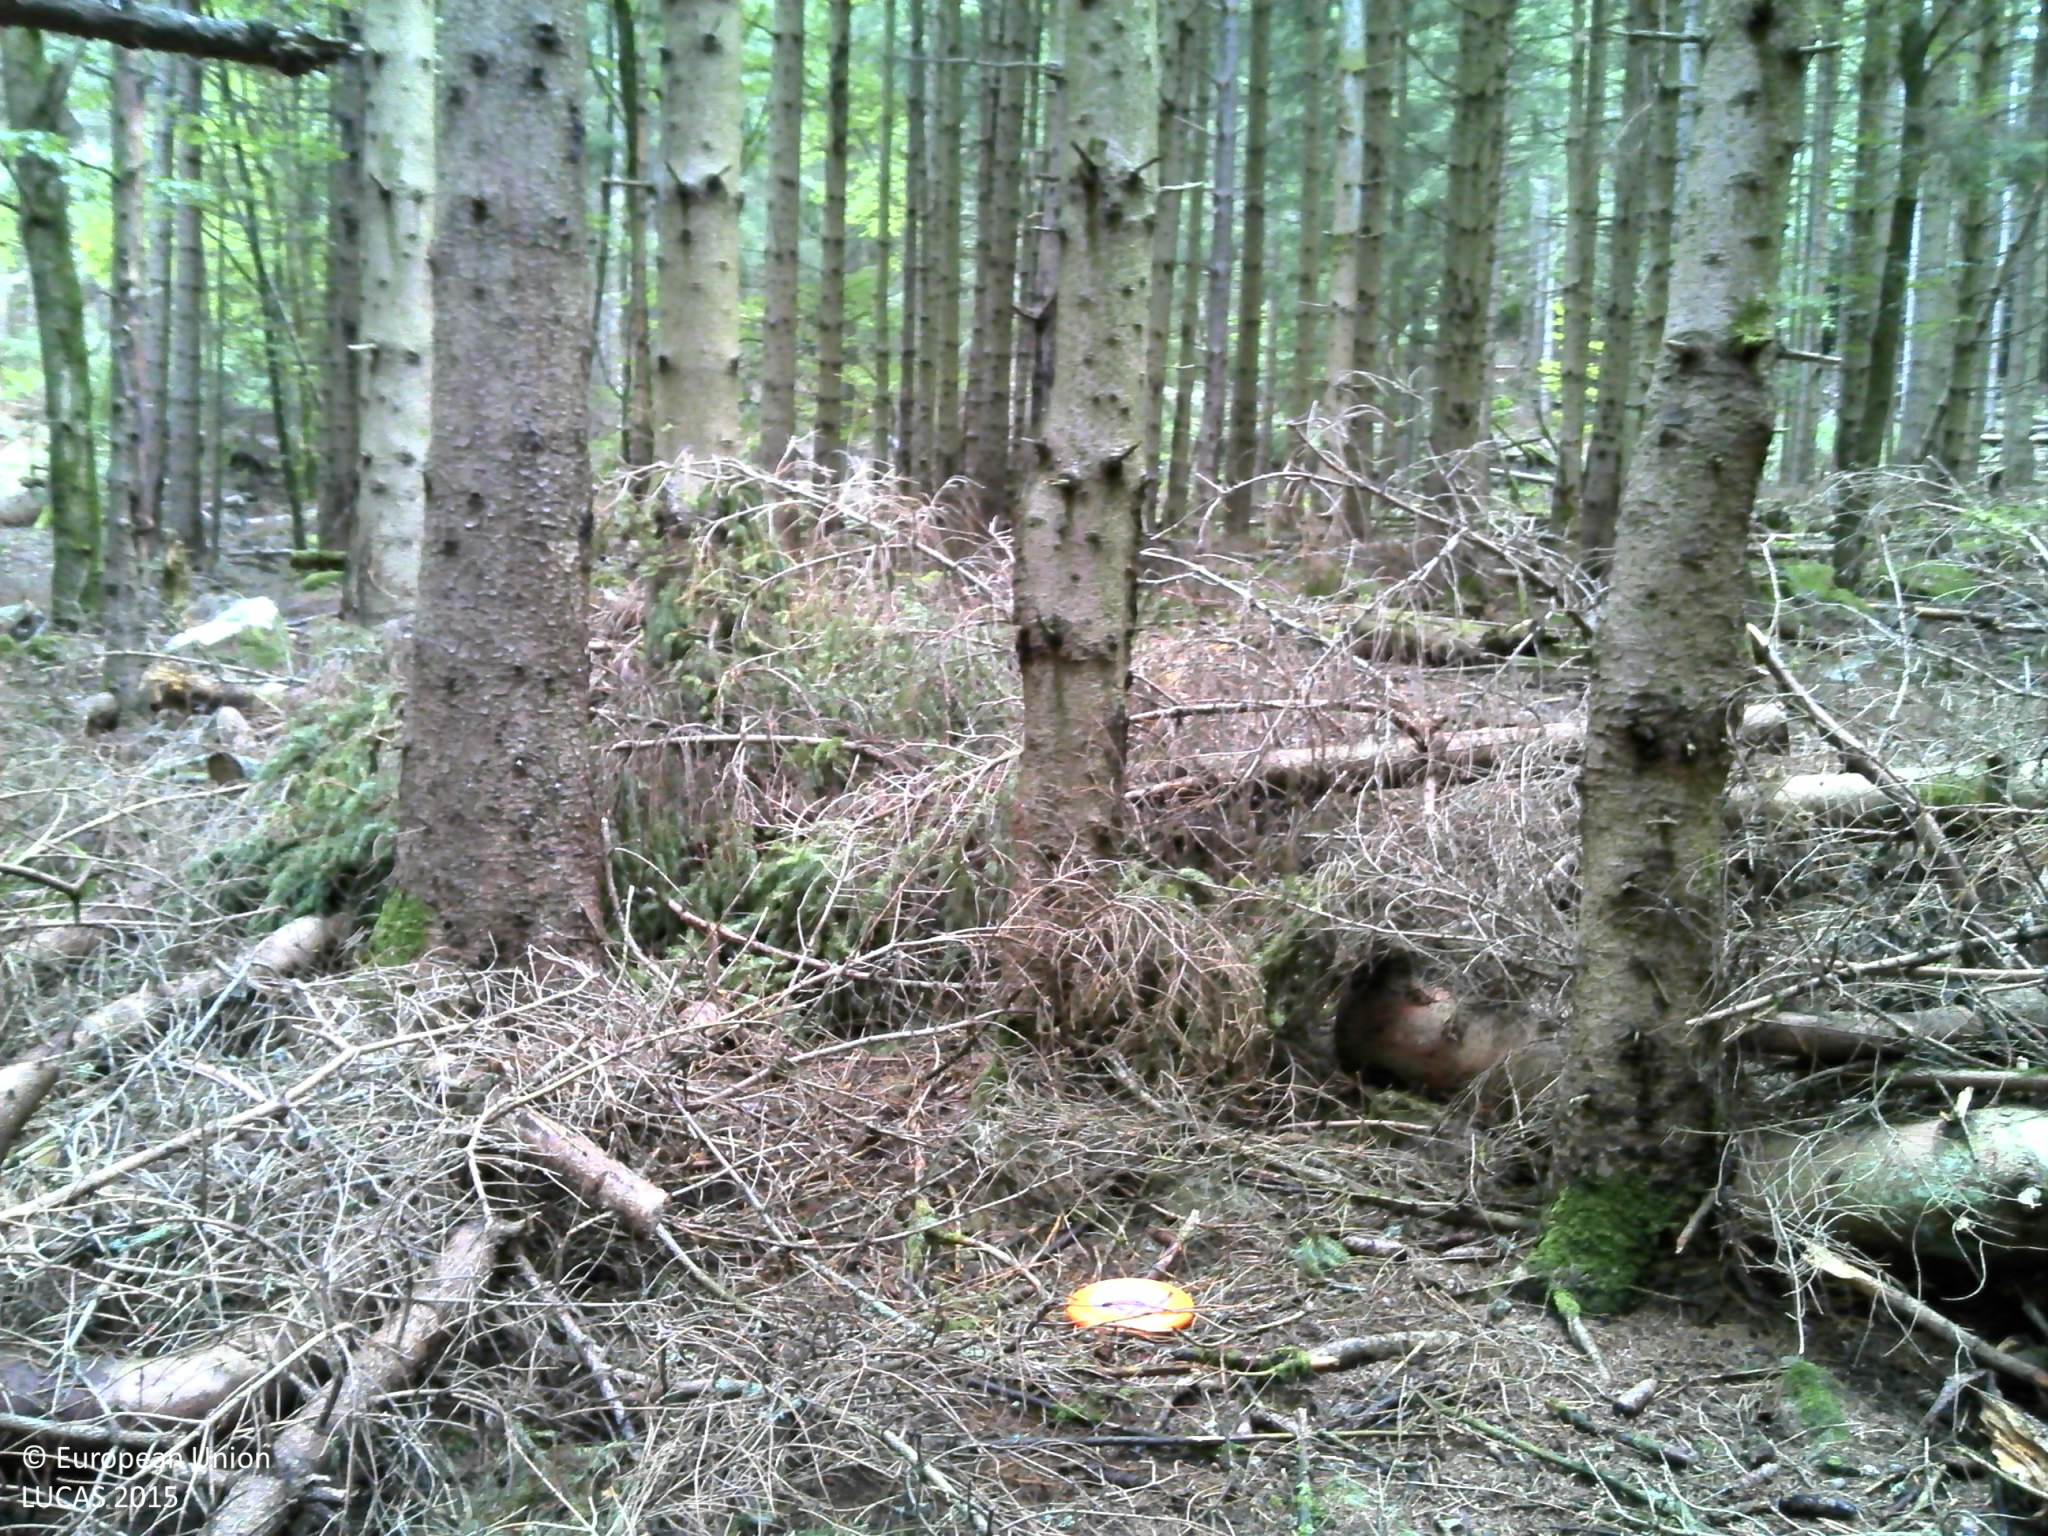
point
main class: Woodland
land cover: Spruce dominated coniferous woodland
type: exotic forest
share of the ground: > 75 %
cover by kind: coniferous forest trees 90 %, consolidated bare surface 10 %
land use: Forestry
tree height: > 5 m
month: September
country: FR
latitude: 48.4255
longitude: 7.3386
